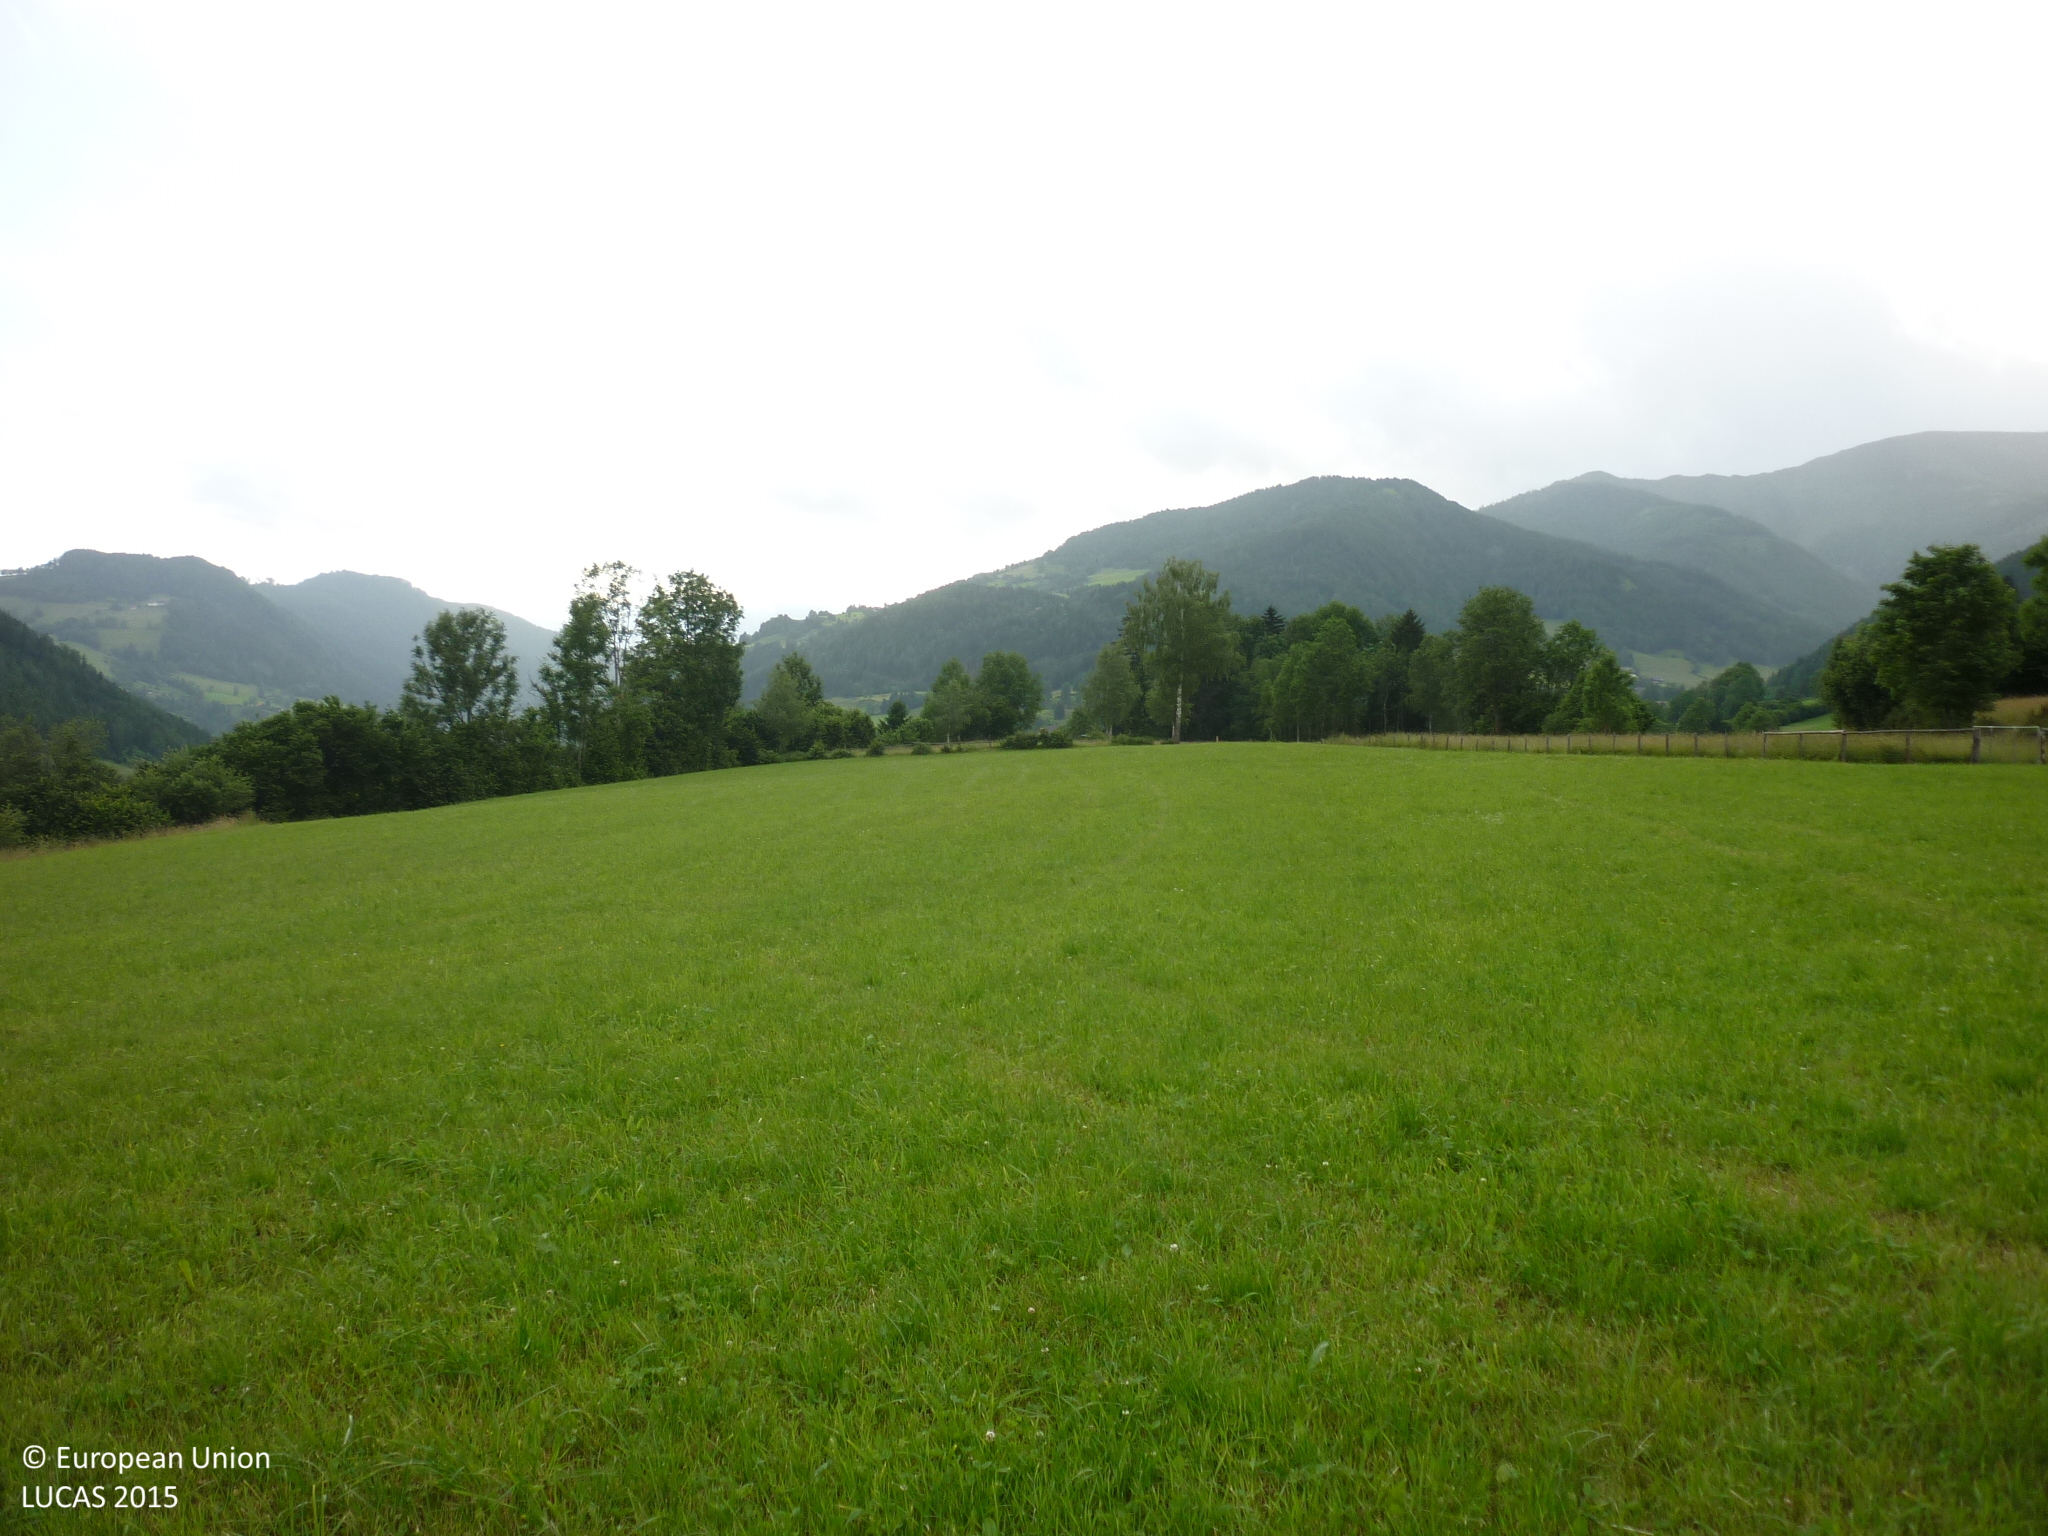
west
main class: Grassland
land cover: Grassland without tree/shrub cover
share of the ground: > 75 %
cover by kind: herbaceous plants 100 %
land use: Agriculture (excluding fallow land and kitchen gardens)
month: June
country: AT
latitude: 47.1901
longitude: 14.1557
